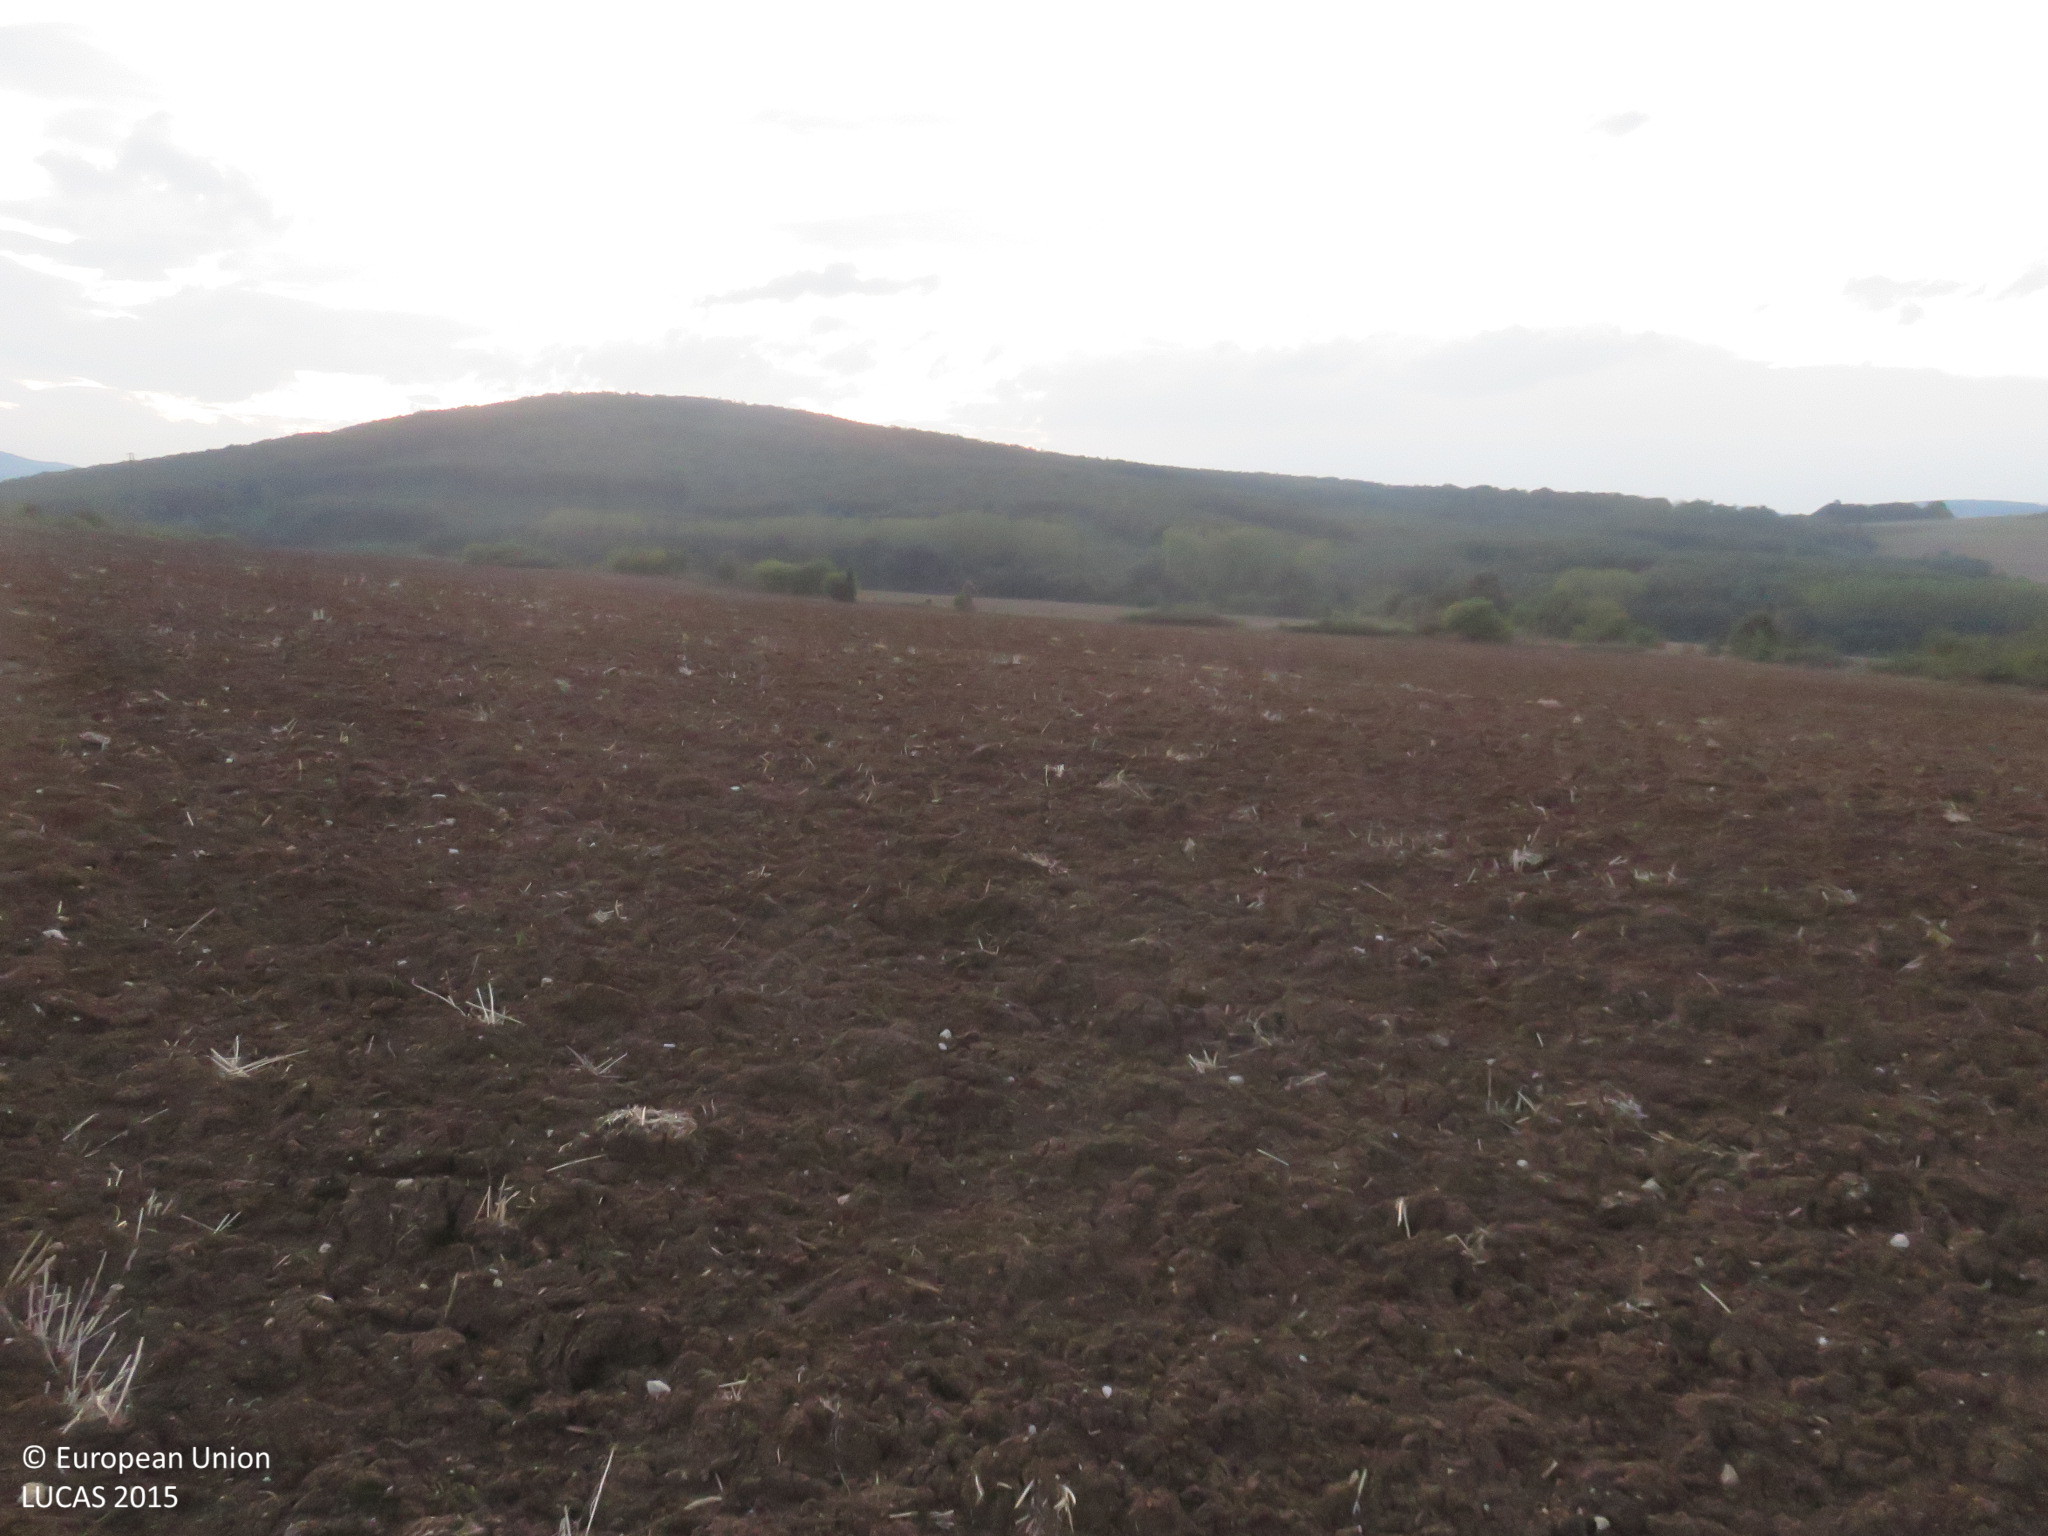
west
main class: Cropland
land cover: Common wheat
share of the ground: < 10 %
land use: Agriculture (excluding fallow land and kitchen gardens)
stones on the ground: < 10 %
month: September
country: BG
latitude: 43.0679
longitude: 25.0119
